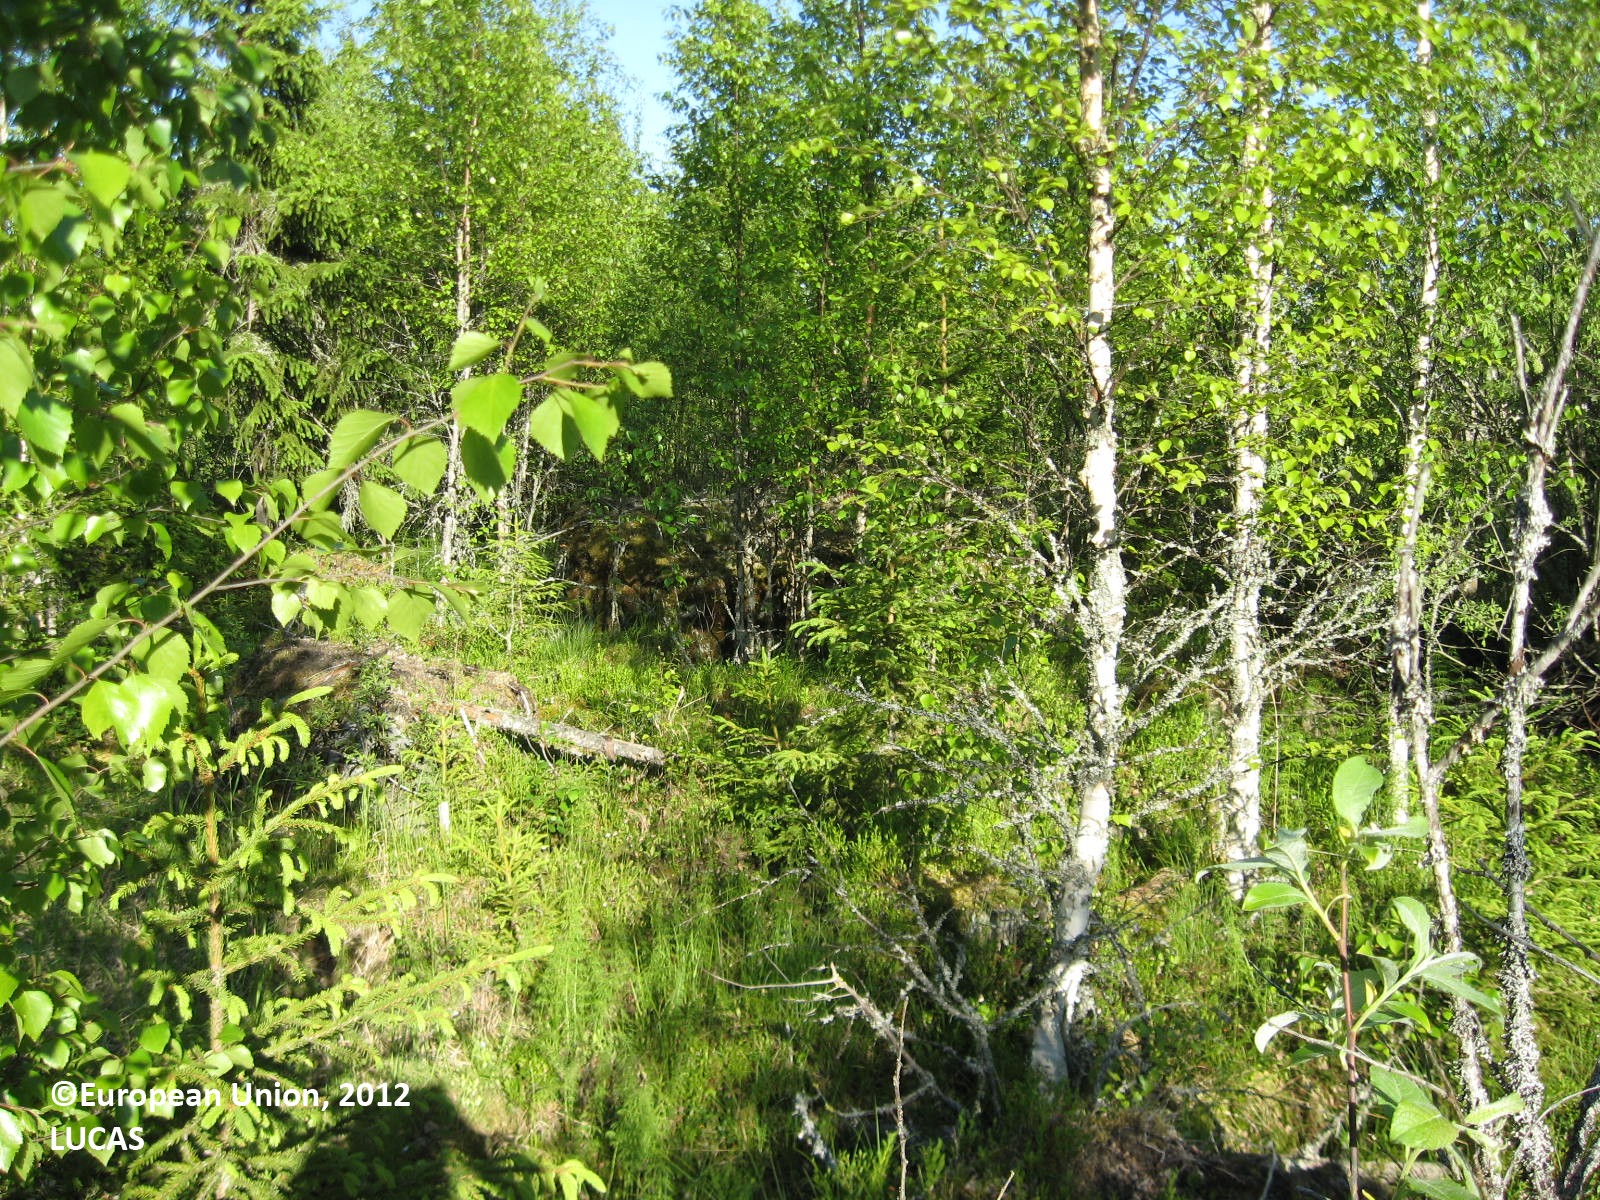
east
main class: Woodland
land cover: Broadleaved woodland
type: boreal forest
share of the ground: > 75 %
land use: Forestry
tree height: > 5 m
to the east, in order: Broadleaved woodland; Spruce dominated mixed woodland; Other mixed woodland; Pine dominated coniferous woodland
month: June
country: FI
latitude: 62.9438
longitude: 21.8875
